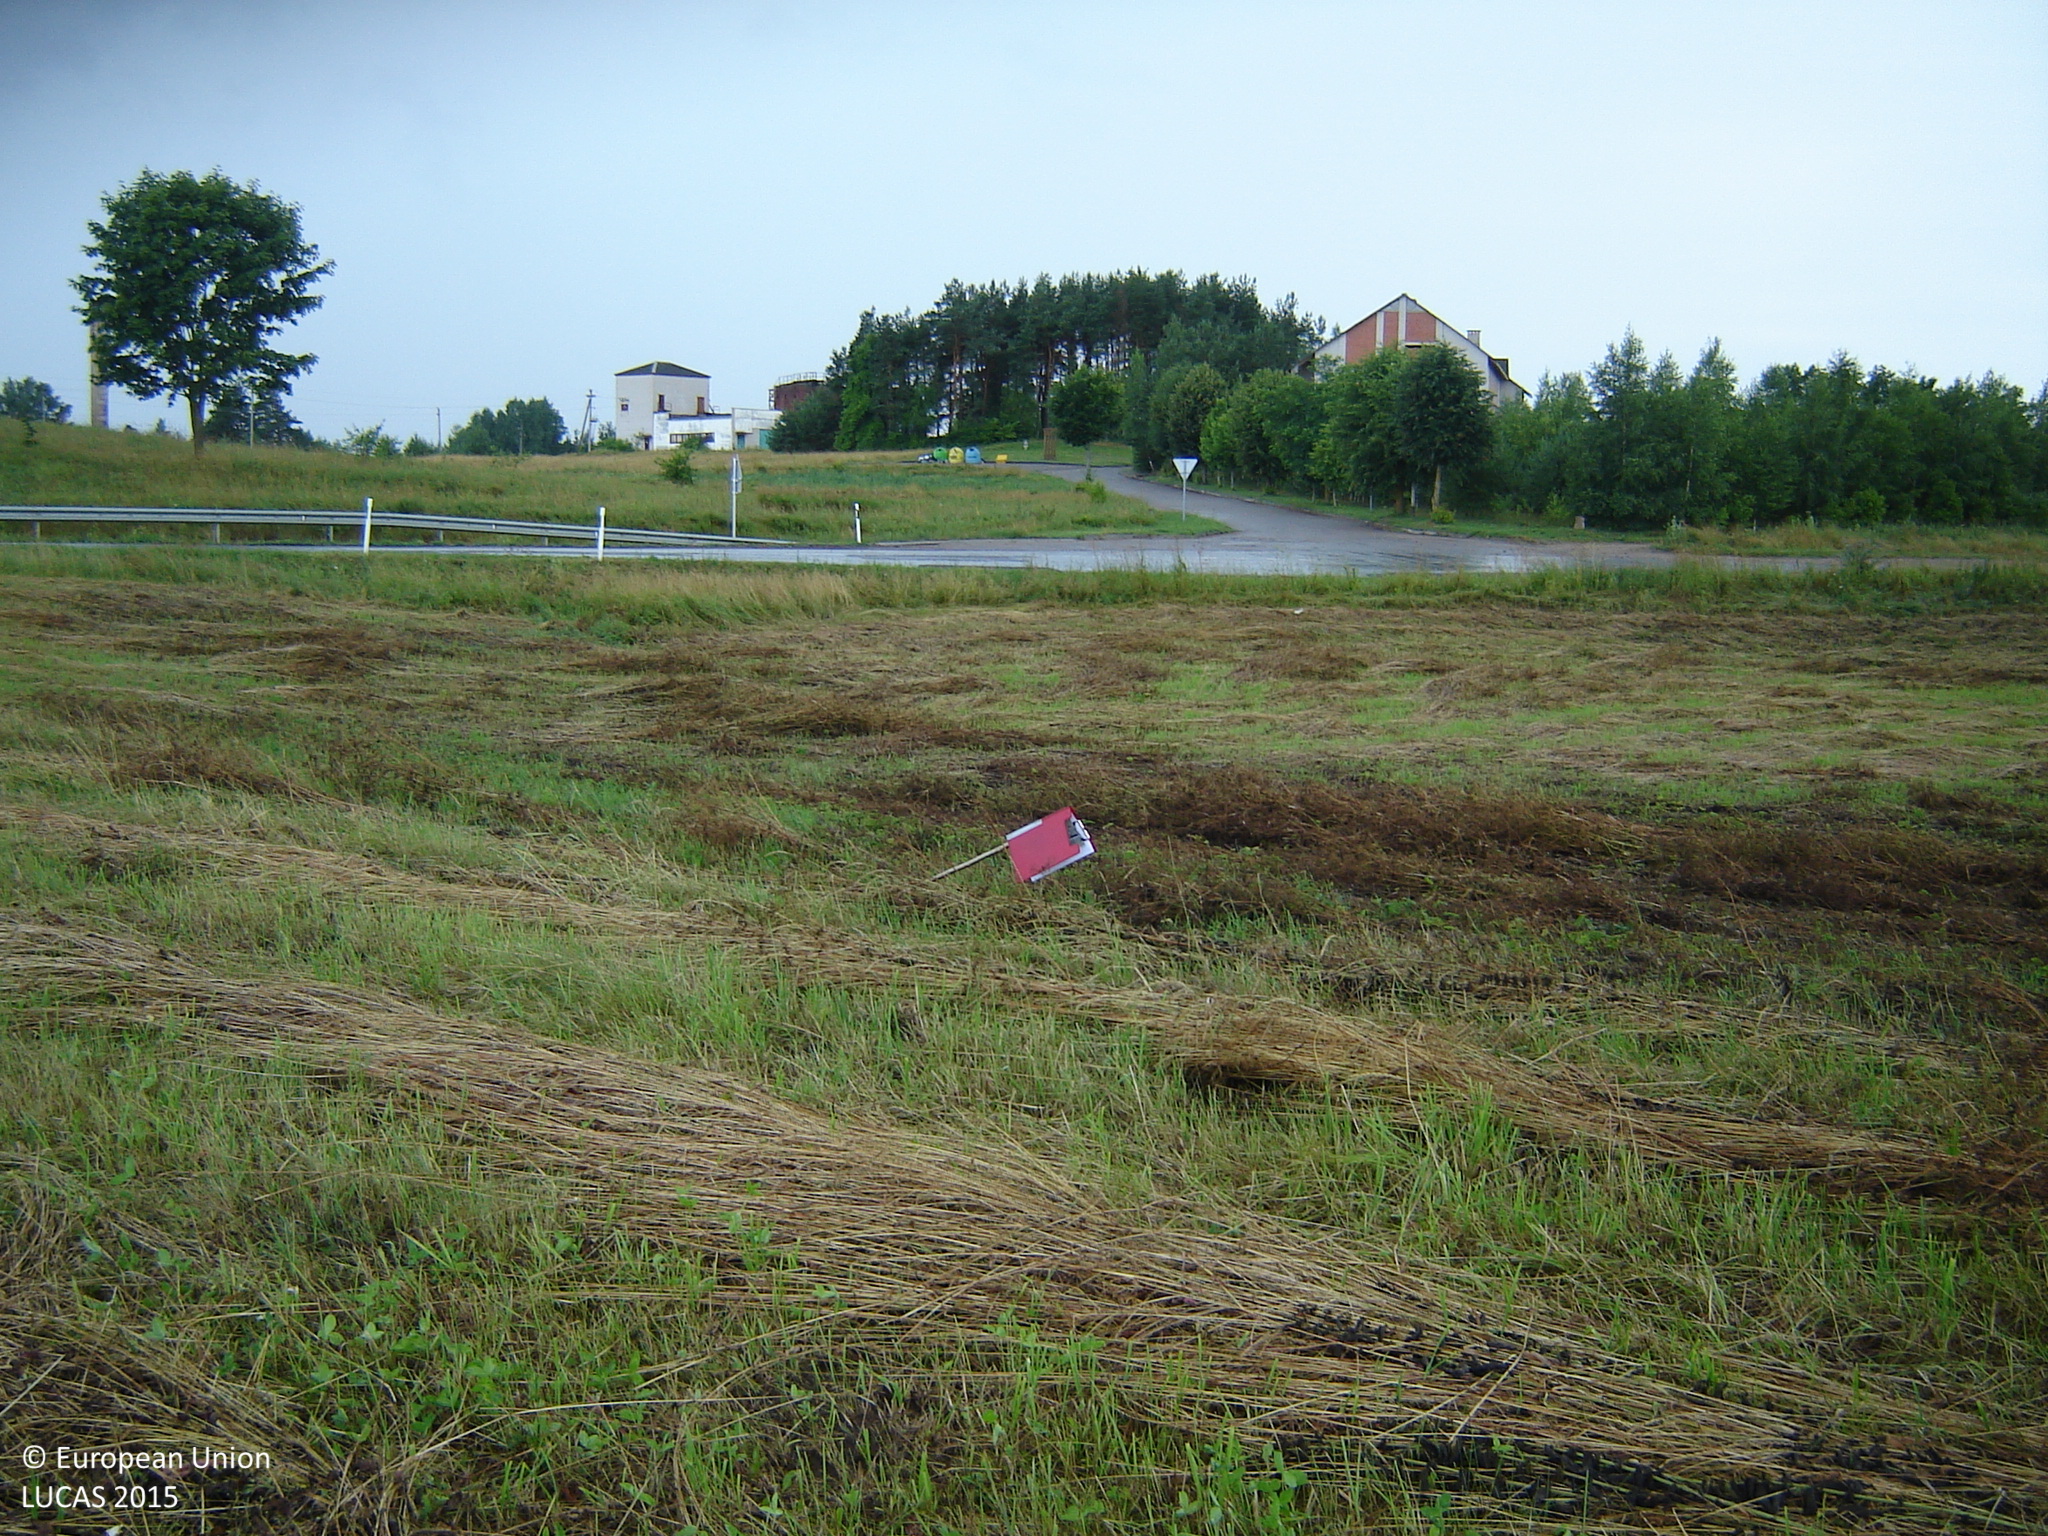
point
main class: Grassland
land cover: Grassland without tree/shrub cover
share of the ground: > 75 %
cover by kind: herbaceous plants 100 %
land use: Agriculture (excluding fallow land and kitchen gardens)
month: July
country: LT
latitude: 55.2326
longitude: 25.3907
